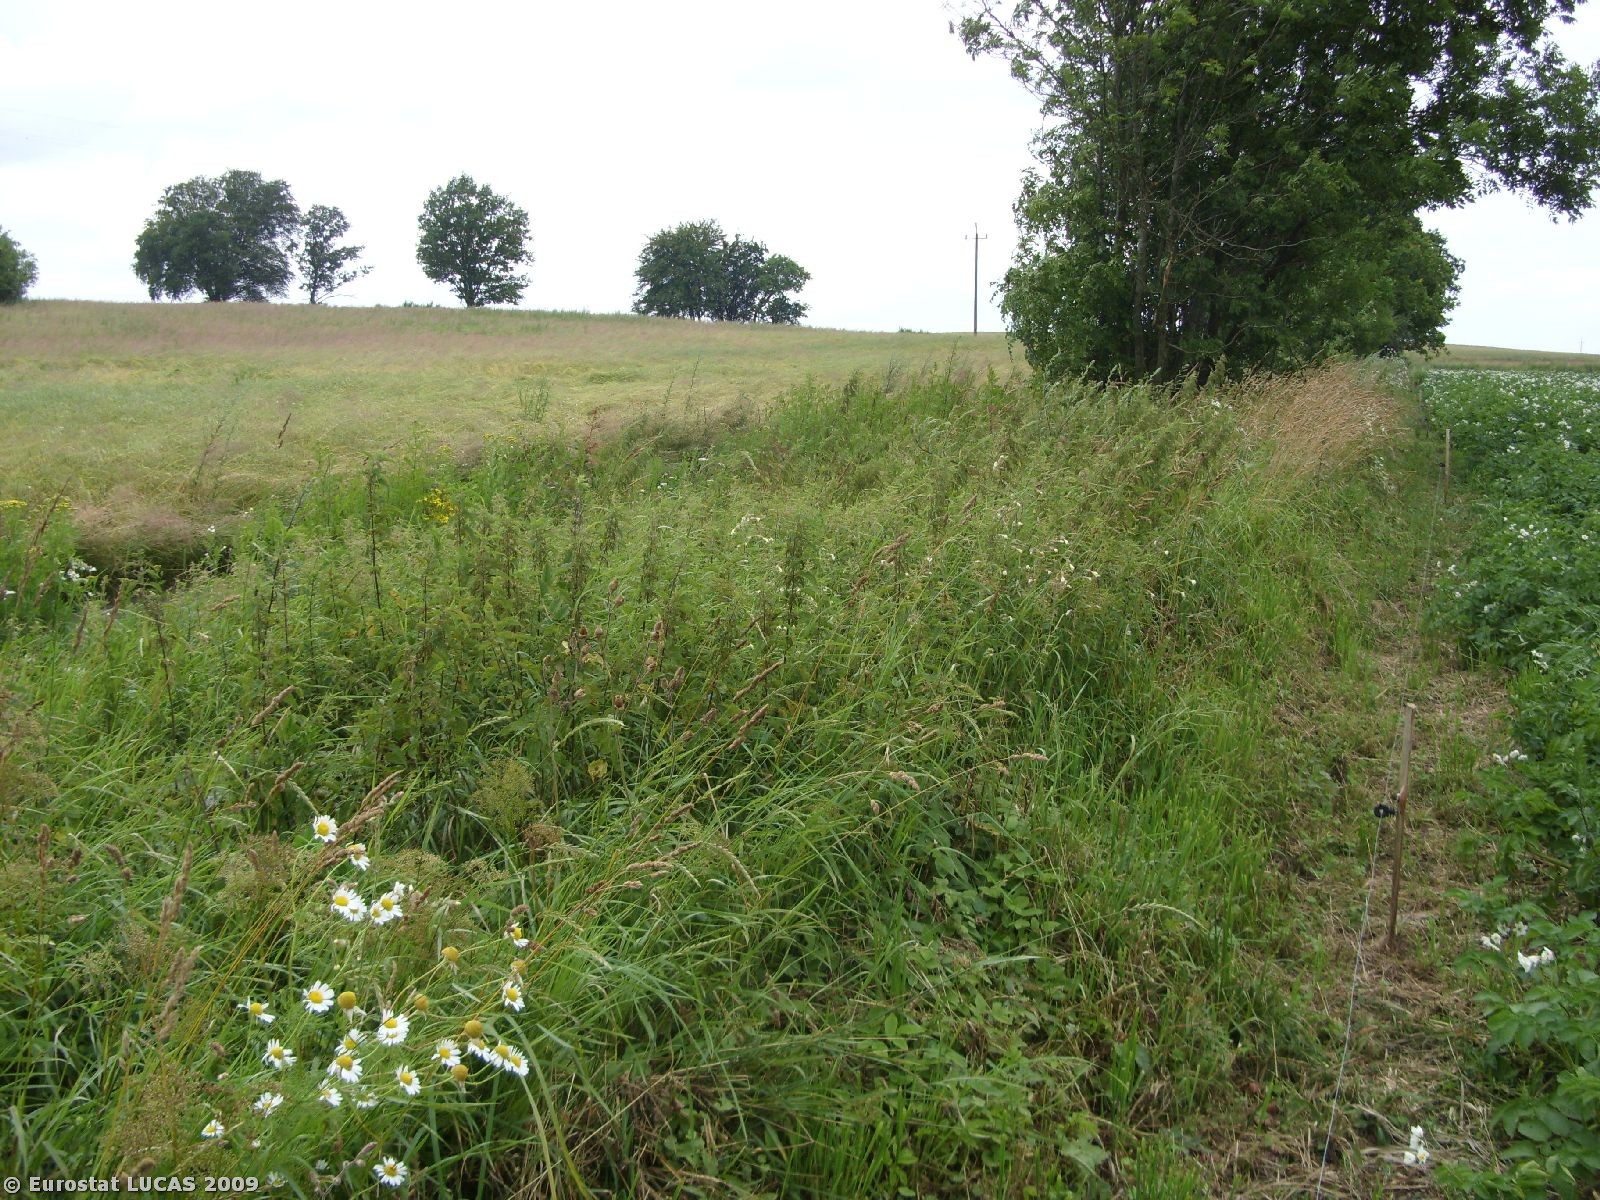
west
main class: Cropland
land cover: Potatoes
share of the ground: > 75 %
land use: Agriculture (excluding fallow land and kitchen gardens)
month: July
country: PL
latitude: 54.0303
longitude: 15.5754
